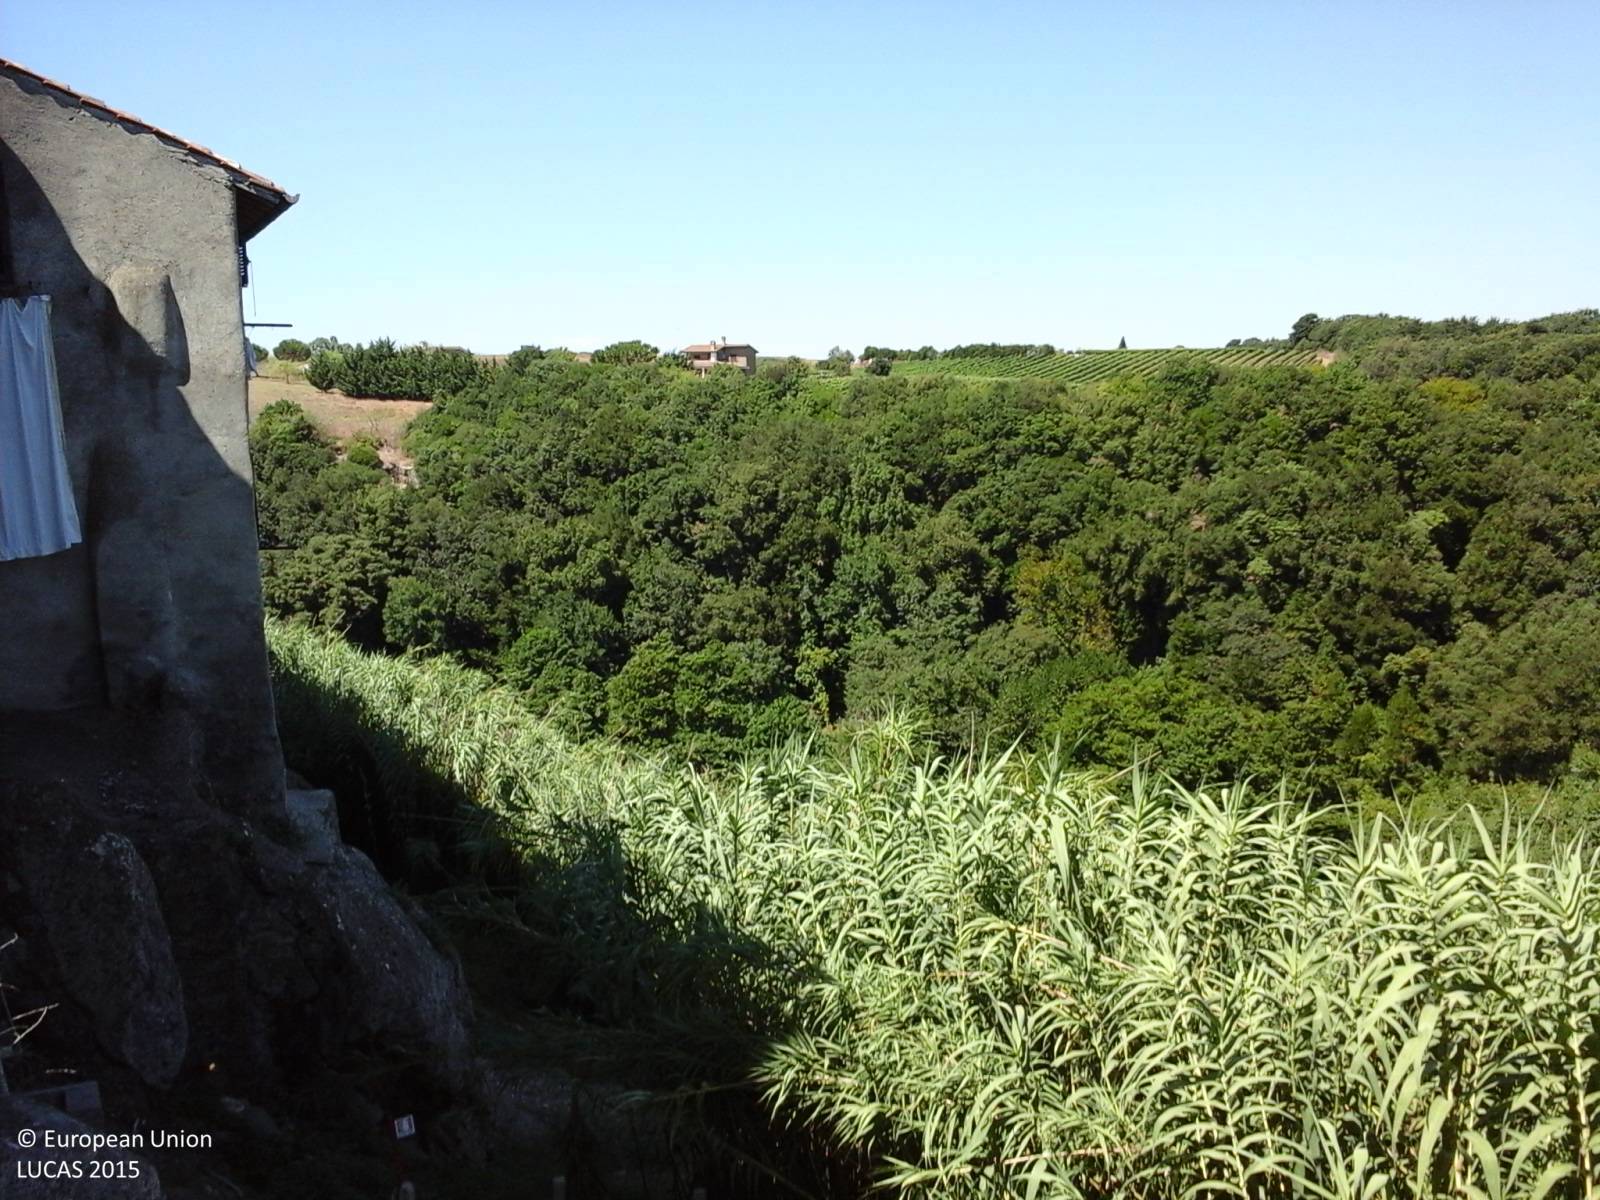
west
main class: Woodland
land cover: Broadleaved woodland
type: thermophilous deciduous forest
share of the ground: > 75 %
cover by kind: broadleaved forest trees 100 %
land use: Forestry
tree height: > 5 m
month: August
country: IT
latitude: 41.9986
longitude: 12.1530
